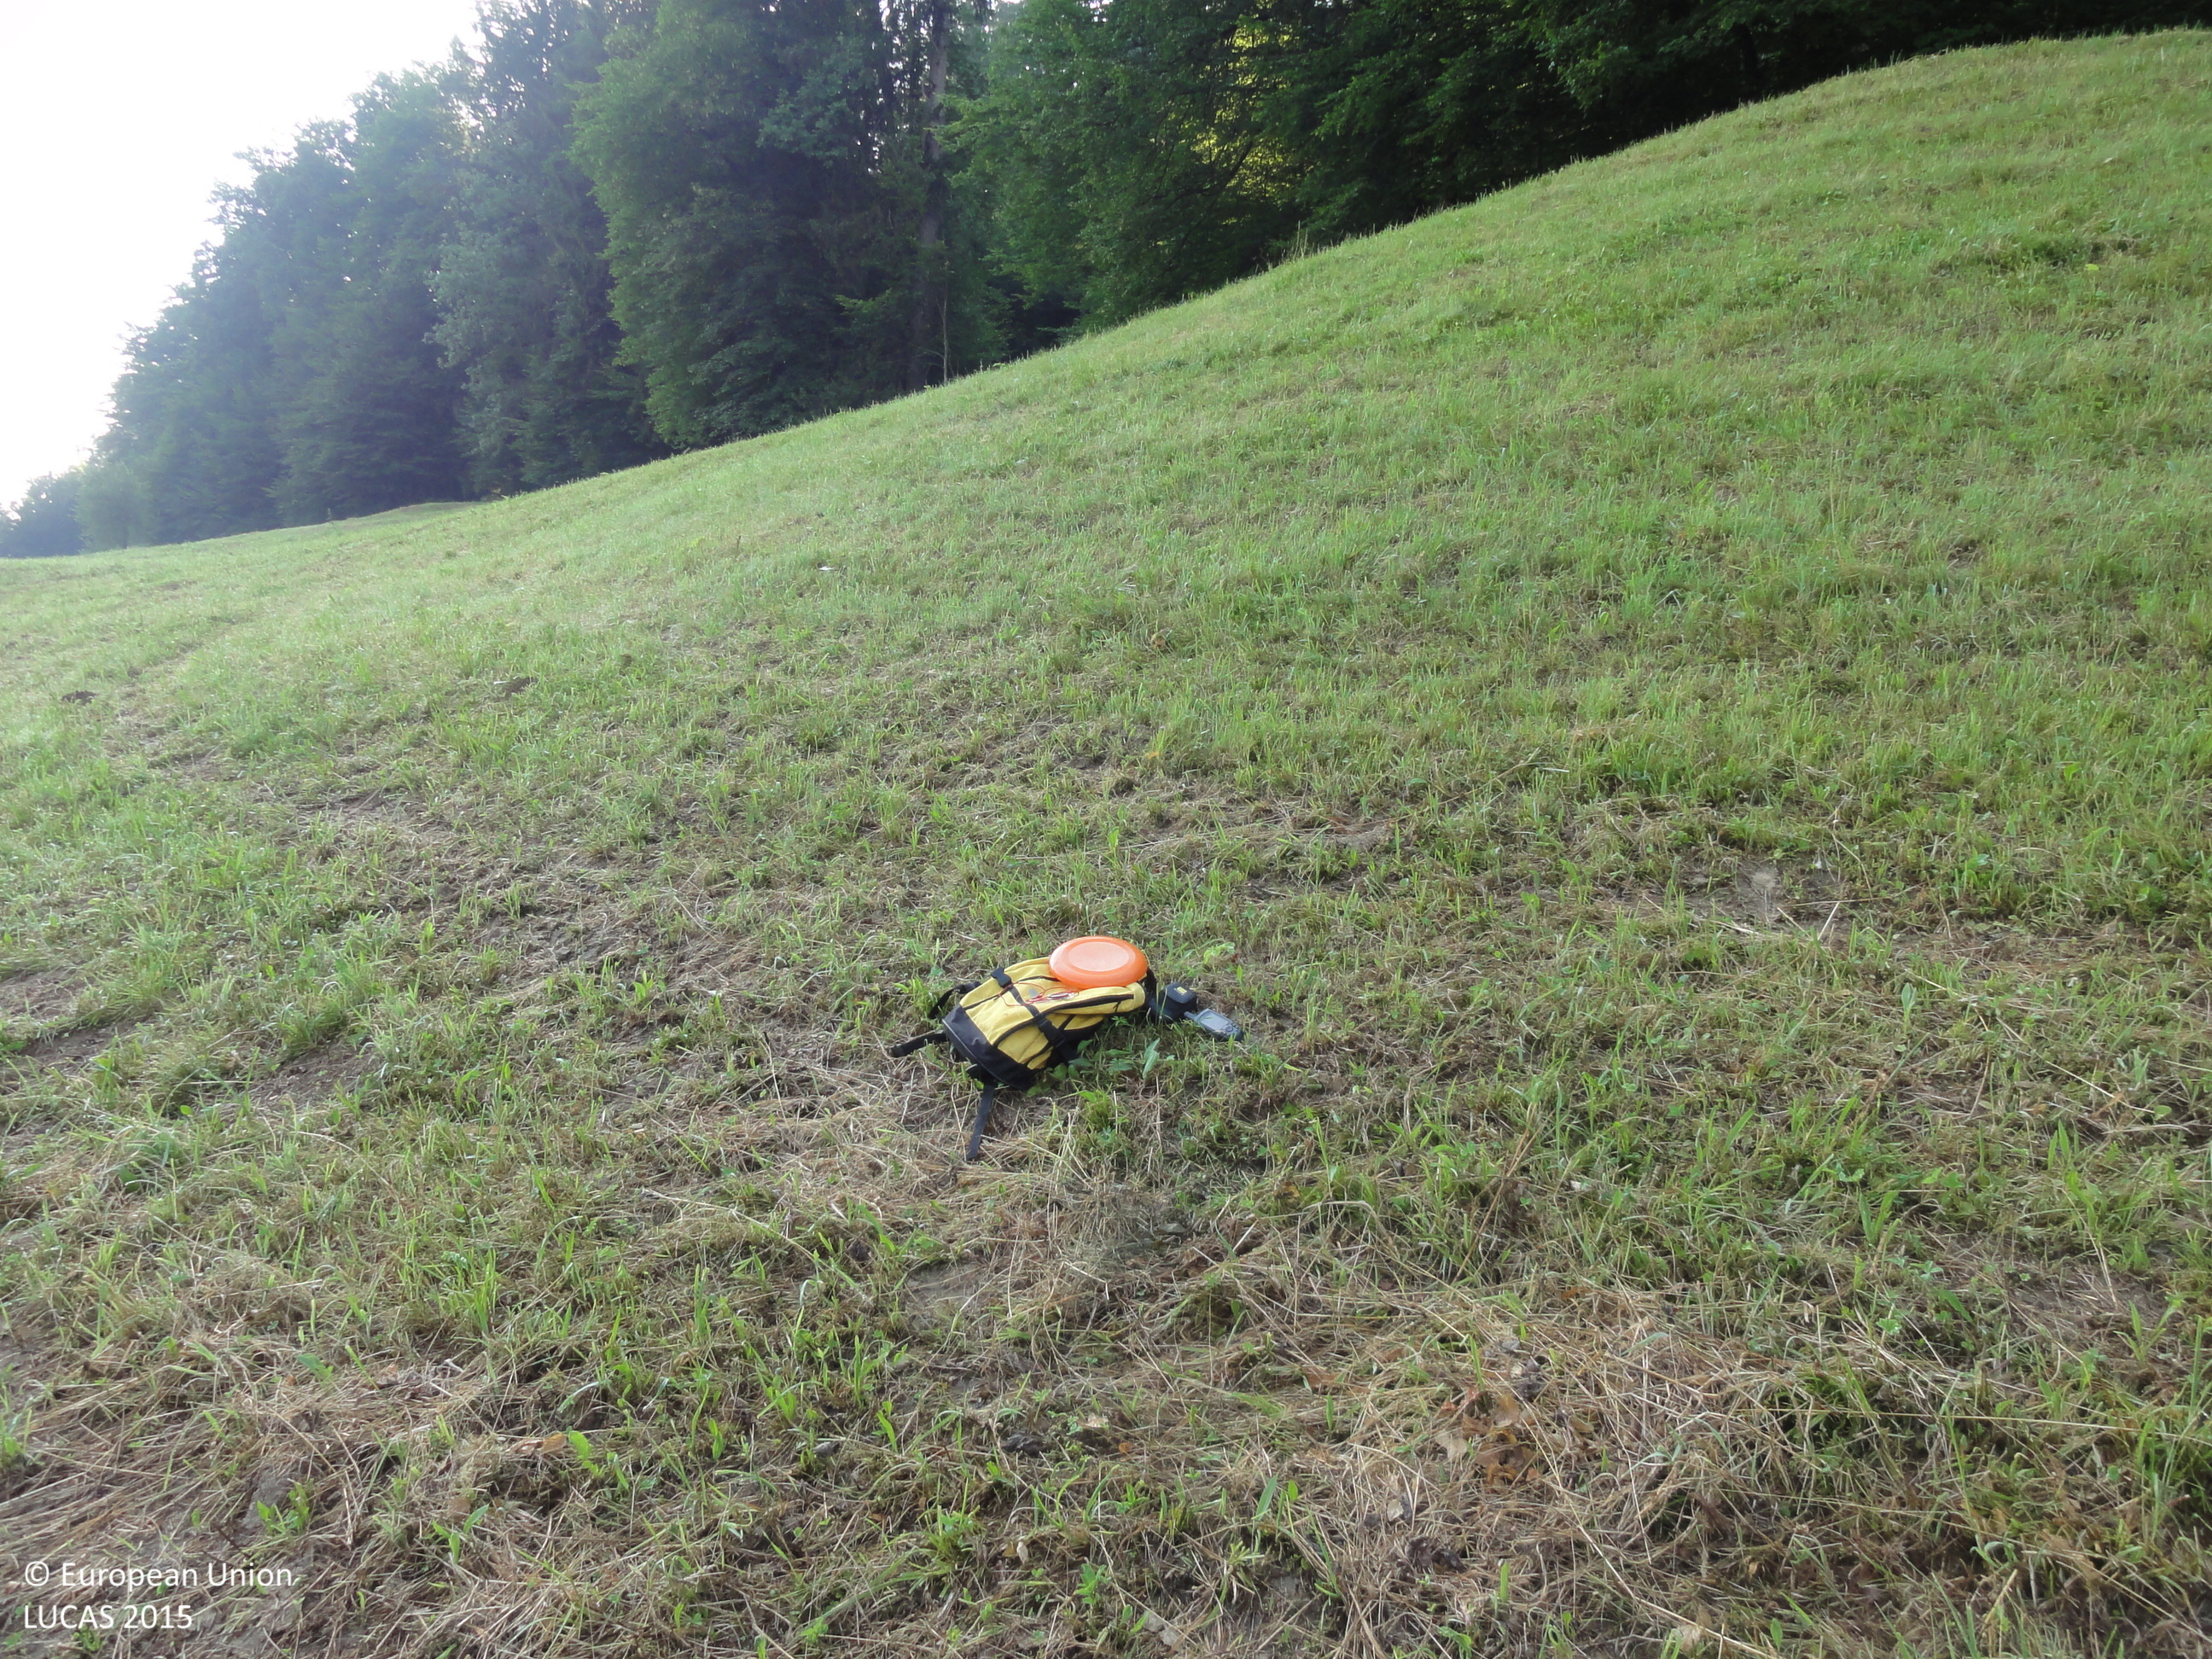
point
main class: Grassland
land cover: Grassland without tree/shrub cover
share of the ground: > 75 %
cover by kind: herbaceous plants 100 %
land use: Agriculture (excluding fallow land and kitchen gardens)
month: July
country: SI
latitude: 46.6389
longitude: 15.5773
